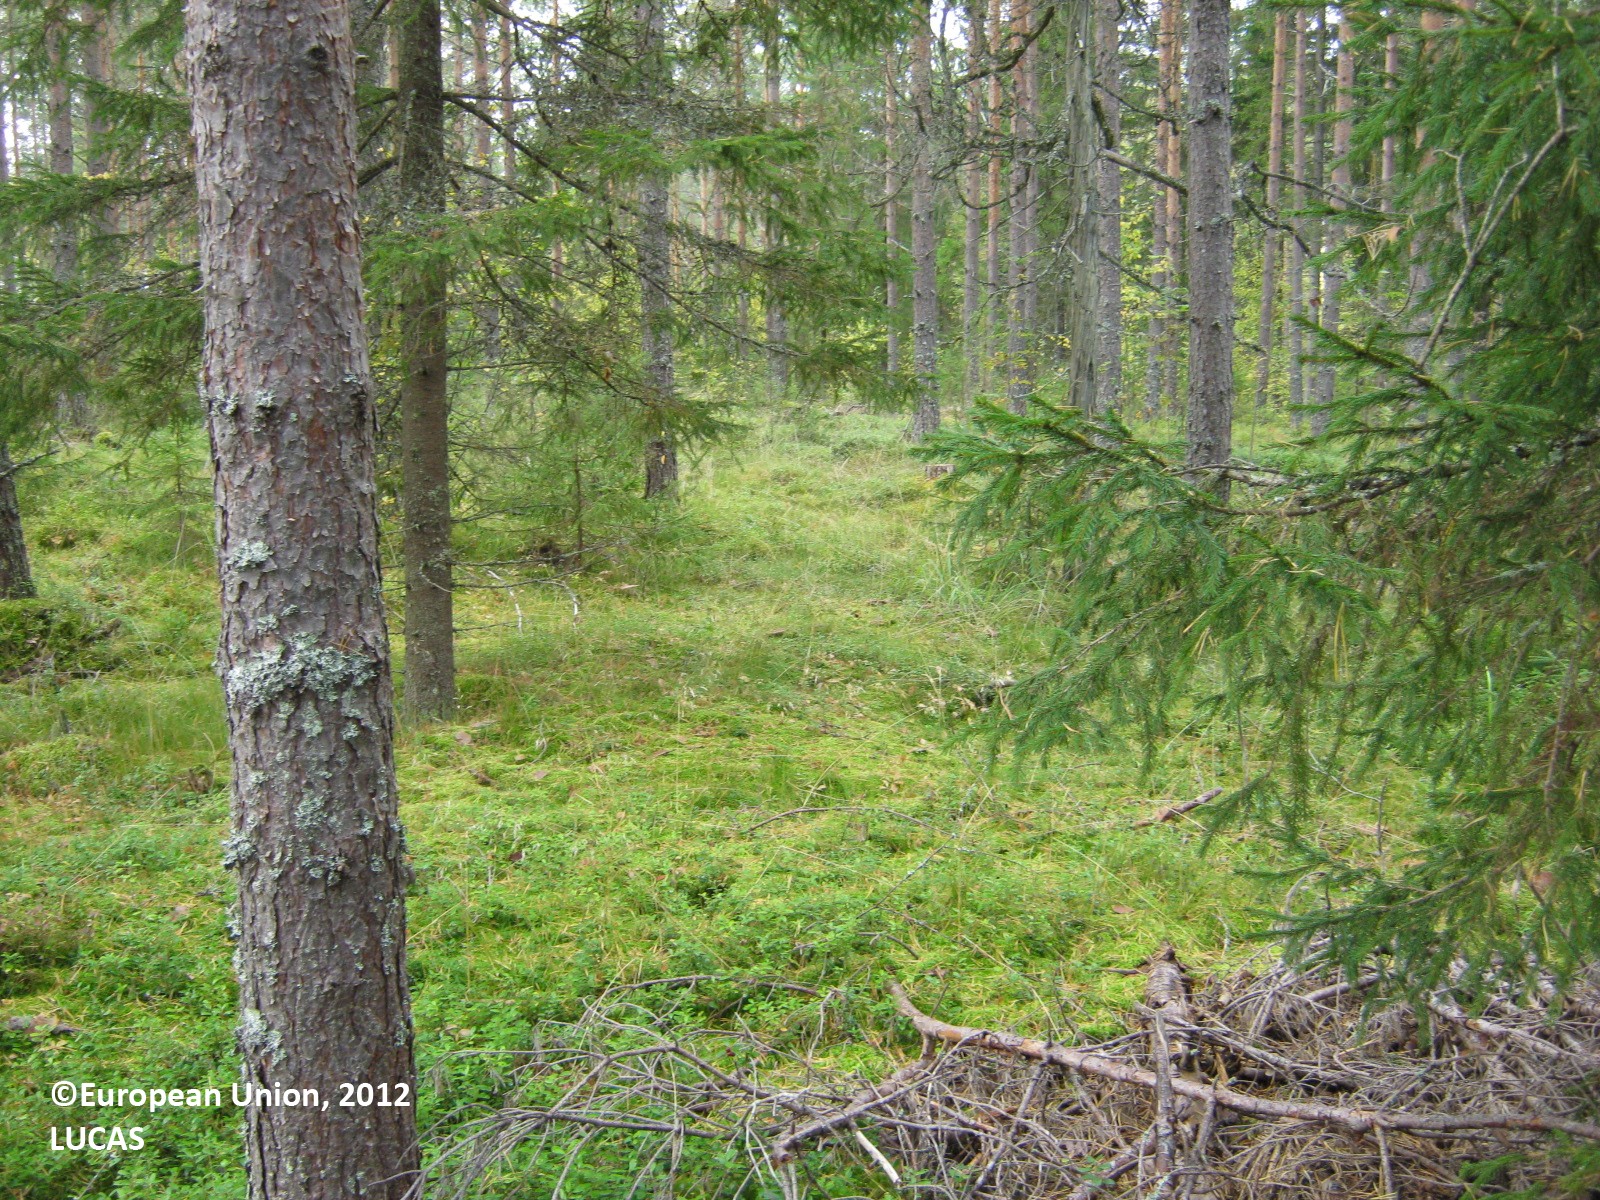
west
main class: Woodland
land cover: Pine dominated coniferous woodland
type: boreal forest
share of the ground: 50 - 75 %
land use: Forestry
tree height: > 5 m
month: September
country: FI
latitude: 60.8525
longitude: 28.0747
